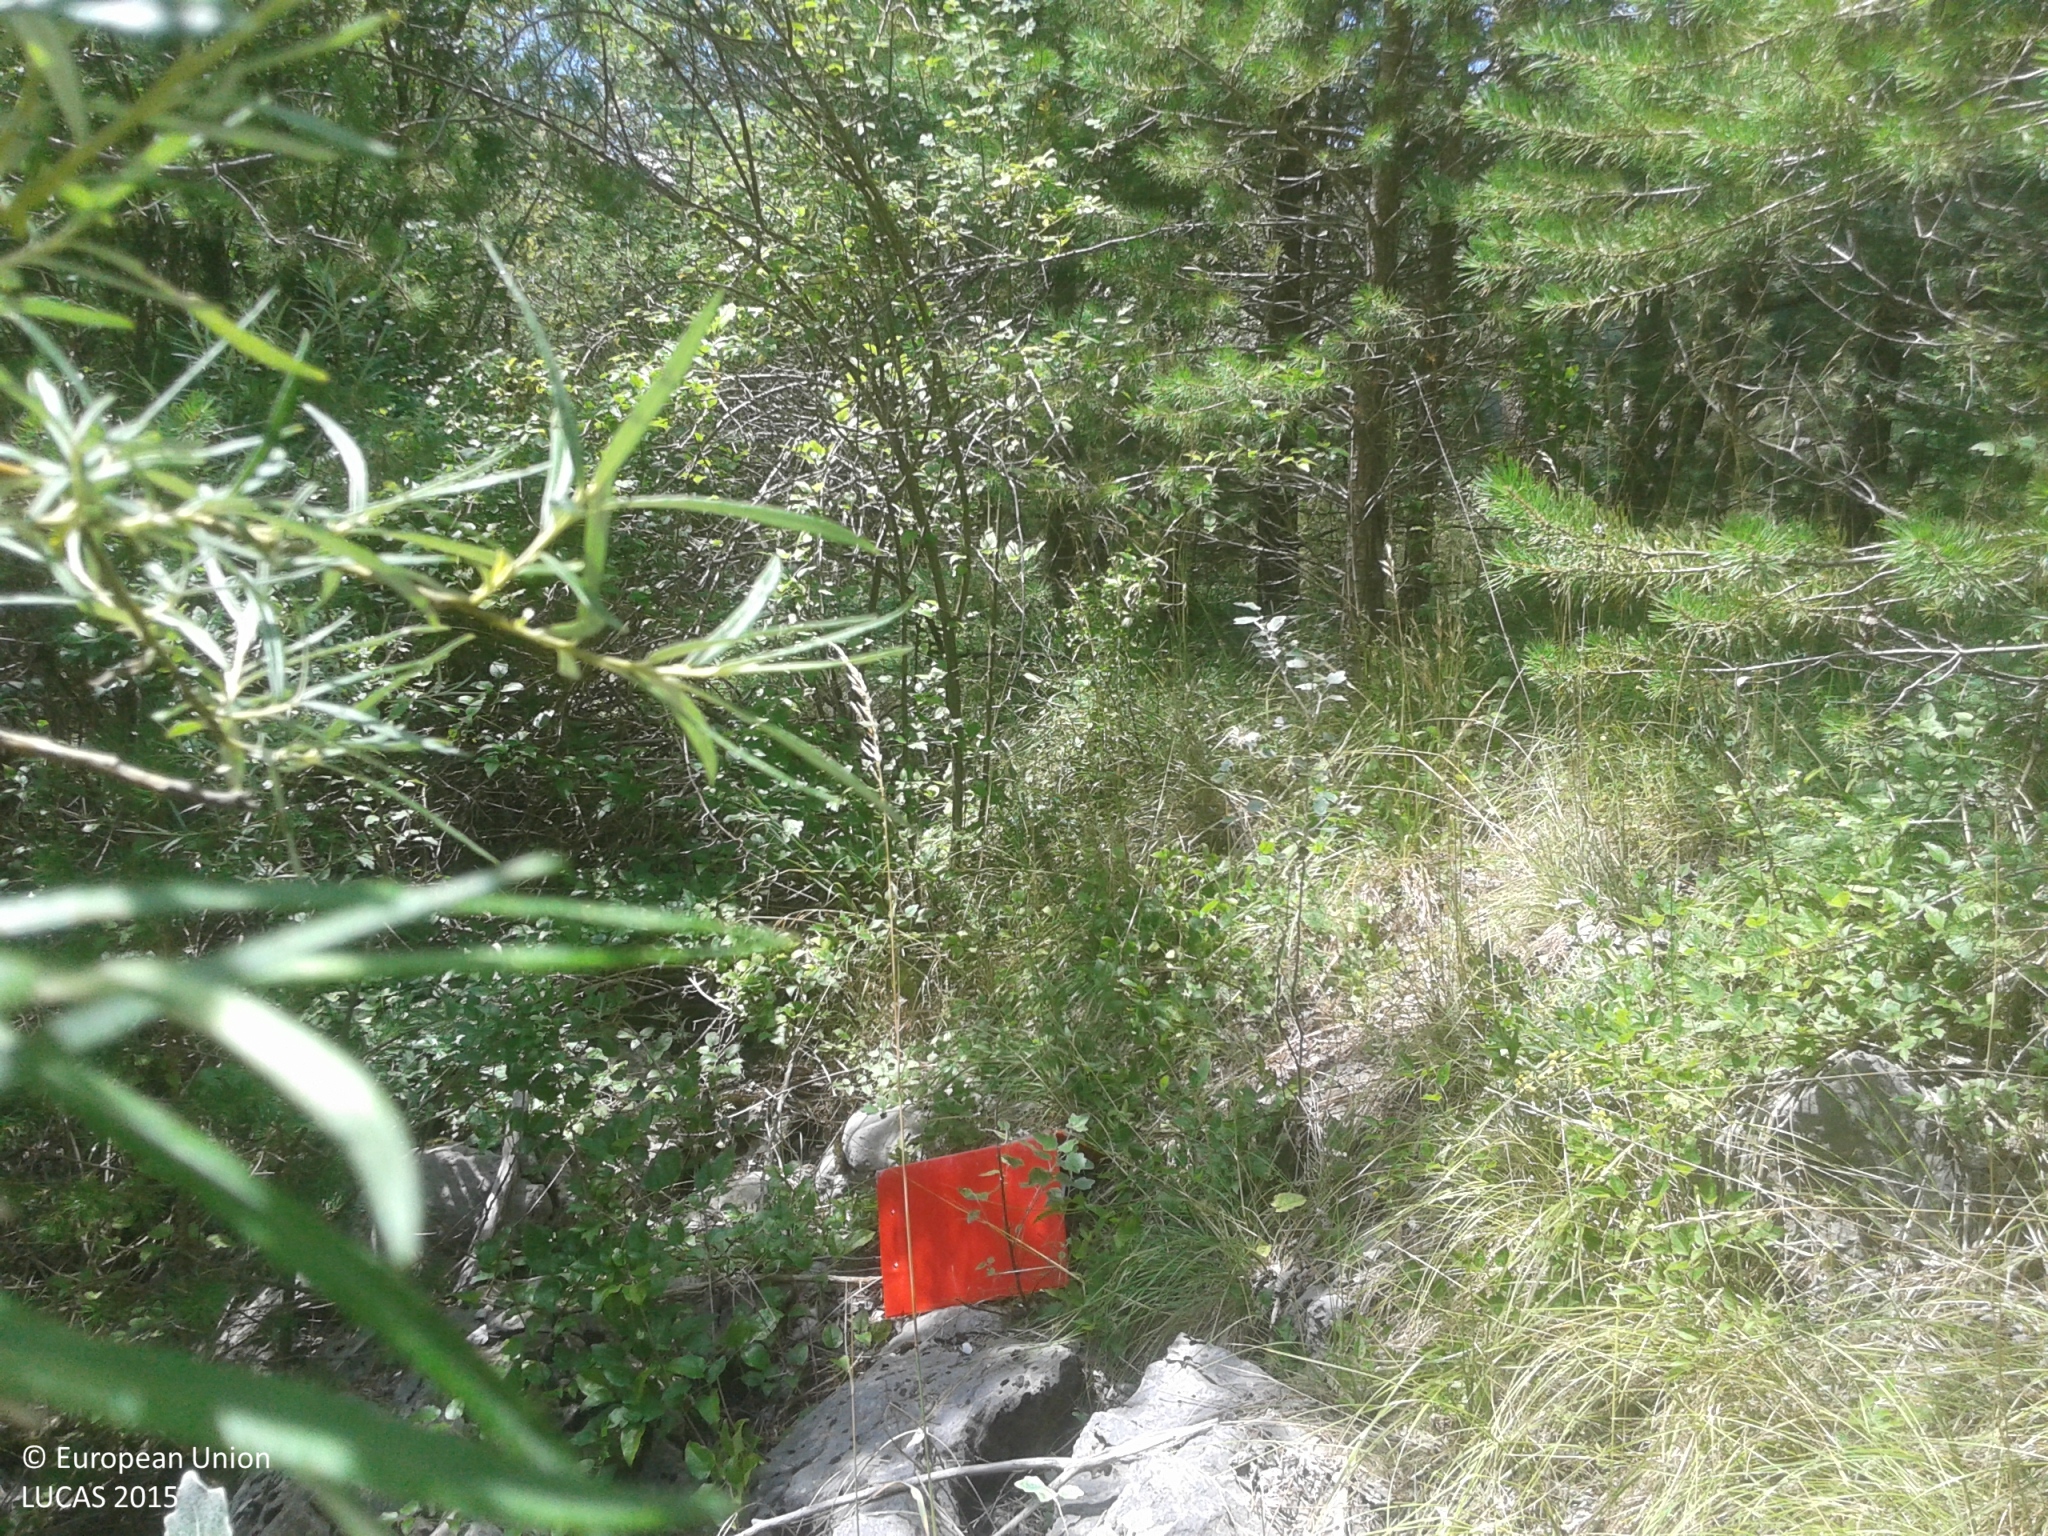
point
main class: Woodland
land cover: Other mixed woodland
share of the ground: > 75 %
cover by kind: broadleaved forest trees 65 %, coniferous forest trees 25 %, shrubs 5 %, herbaceous plants 5 %
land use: Semi-natural and natural areas not in use
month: July
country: ES
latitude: 42.2511
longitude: 1.6117
